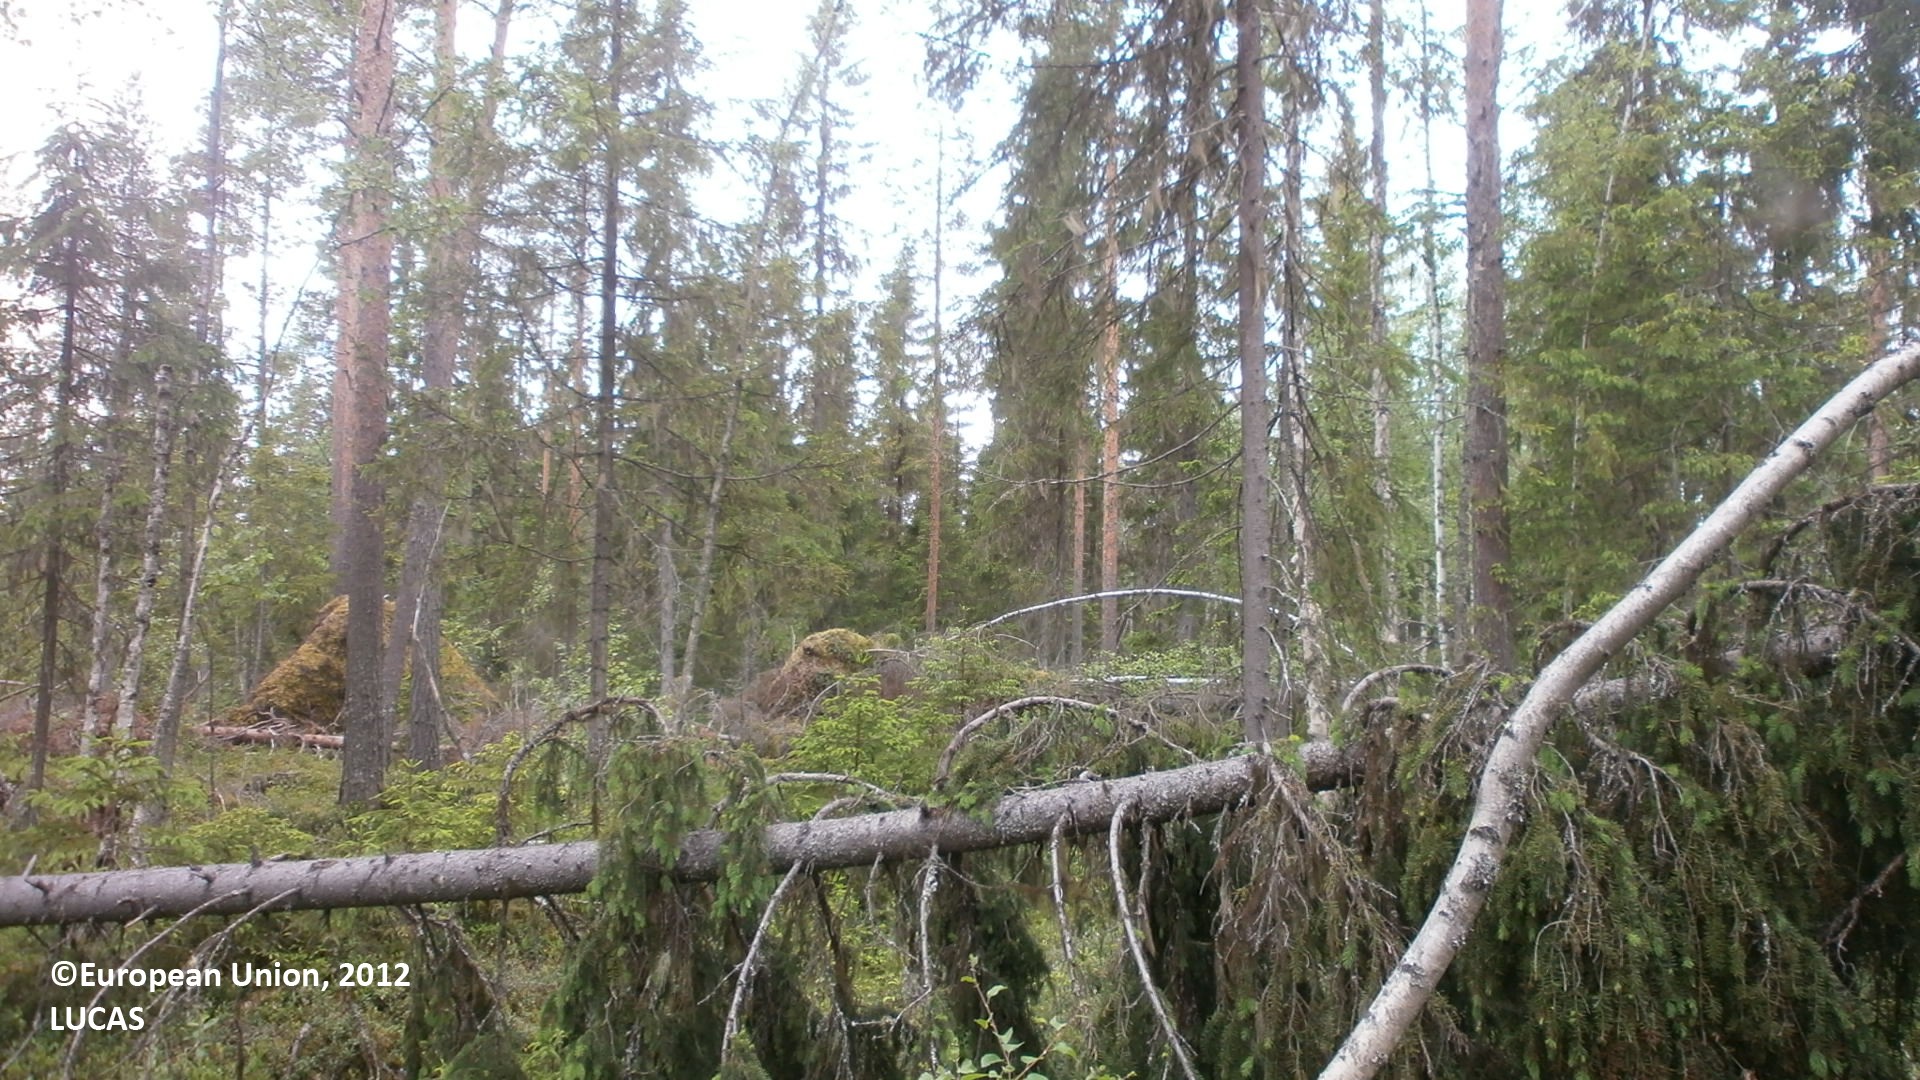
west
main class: Woodland
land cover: Other coniferous woodland
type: boreal forest
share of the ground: 50 - 75 %
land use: Forestry
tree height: > 5 m
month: June
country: FI
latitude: 64.2119
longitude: 25.7779
